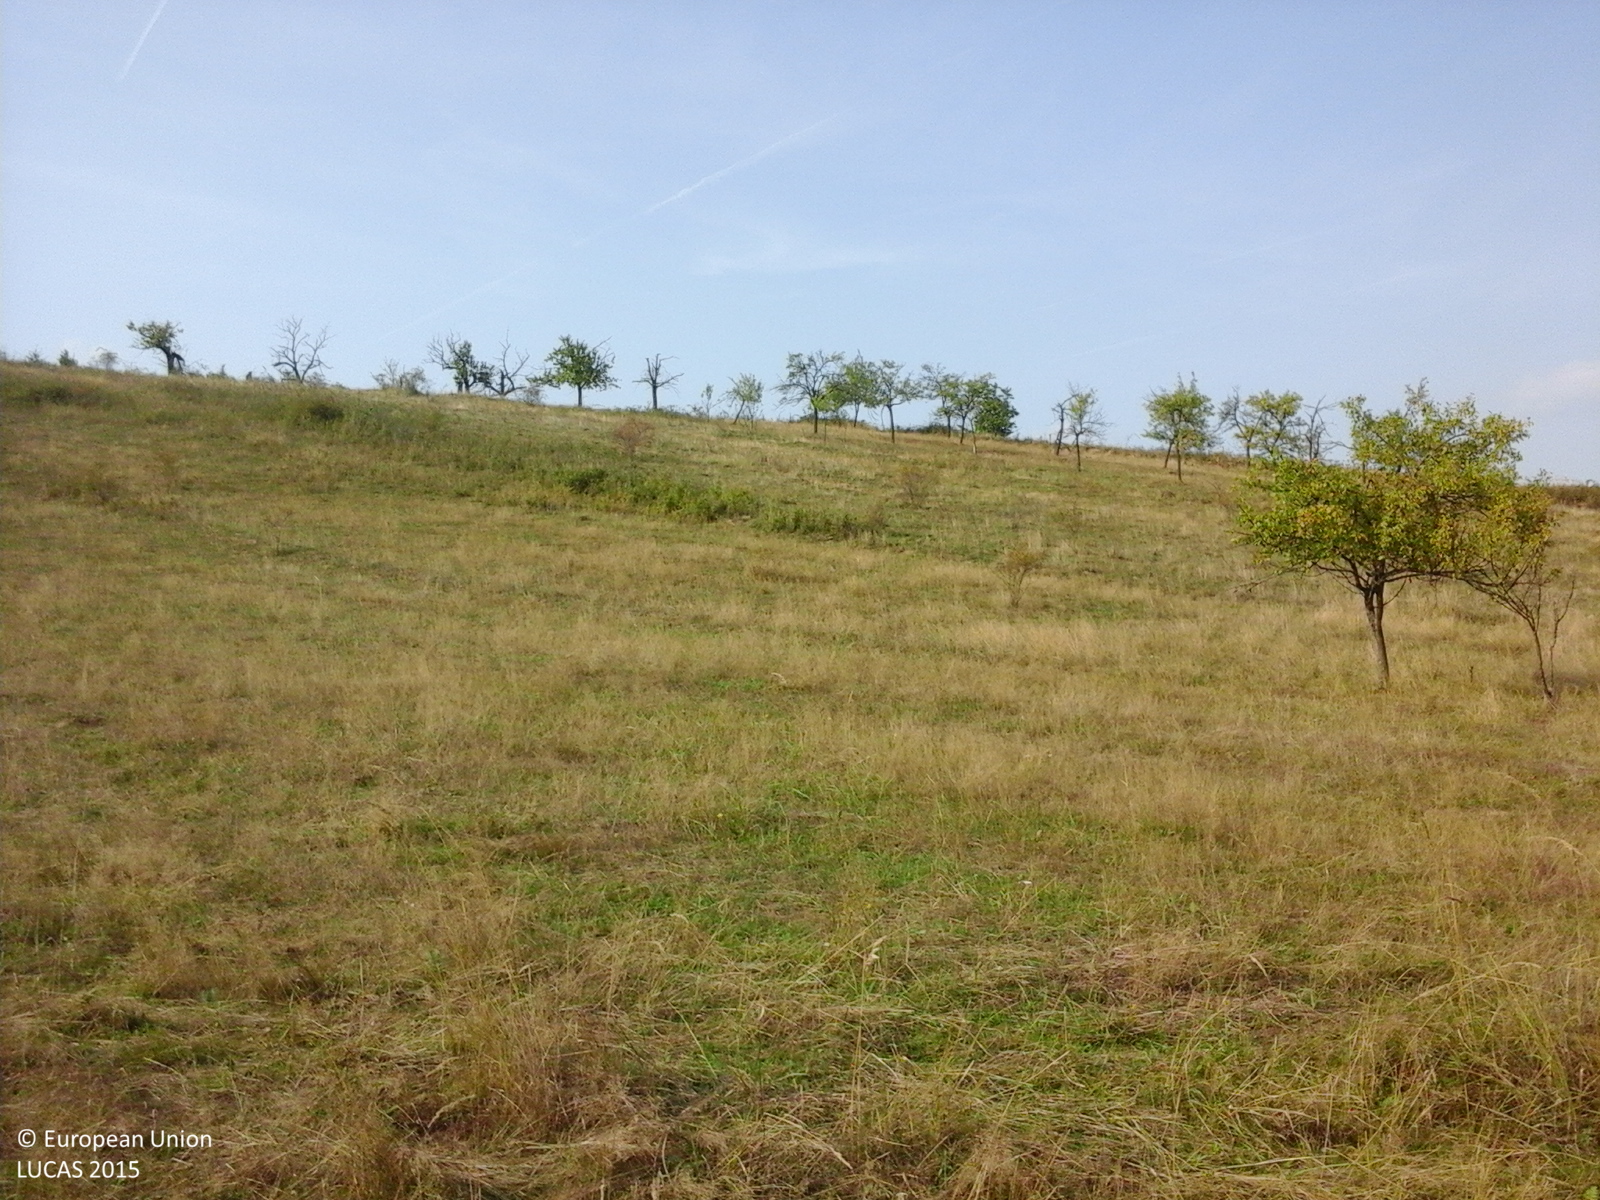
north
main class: Grassland
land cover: Grassland with sparse tree/shrub cover
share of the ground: > 75 %
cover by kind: herbaceous plants 95 %, broadleaved forest trees 5 %
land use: Agriculture (excluding fallow land and kitchen gardens)
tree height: < 5 m
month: September
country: RO
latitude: 45.7865
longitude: 22.1203
